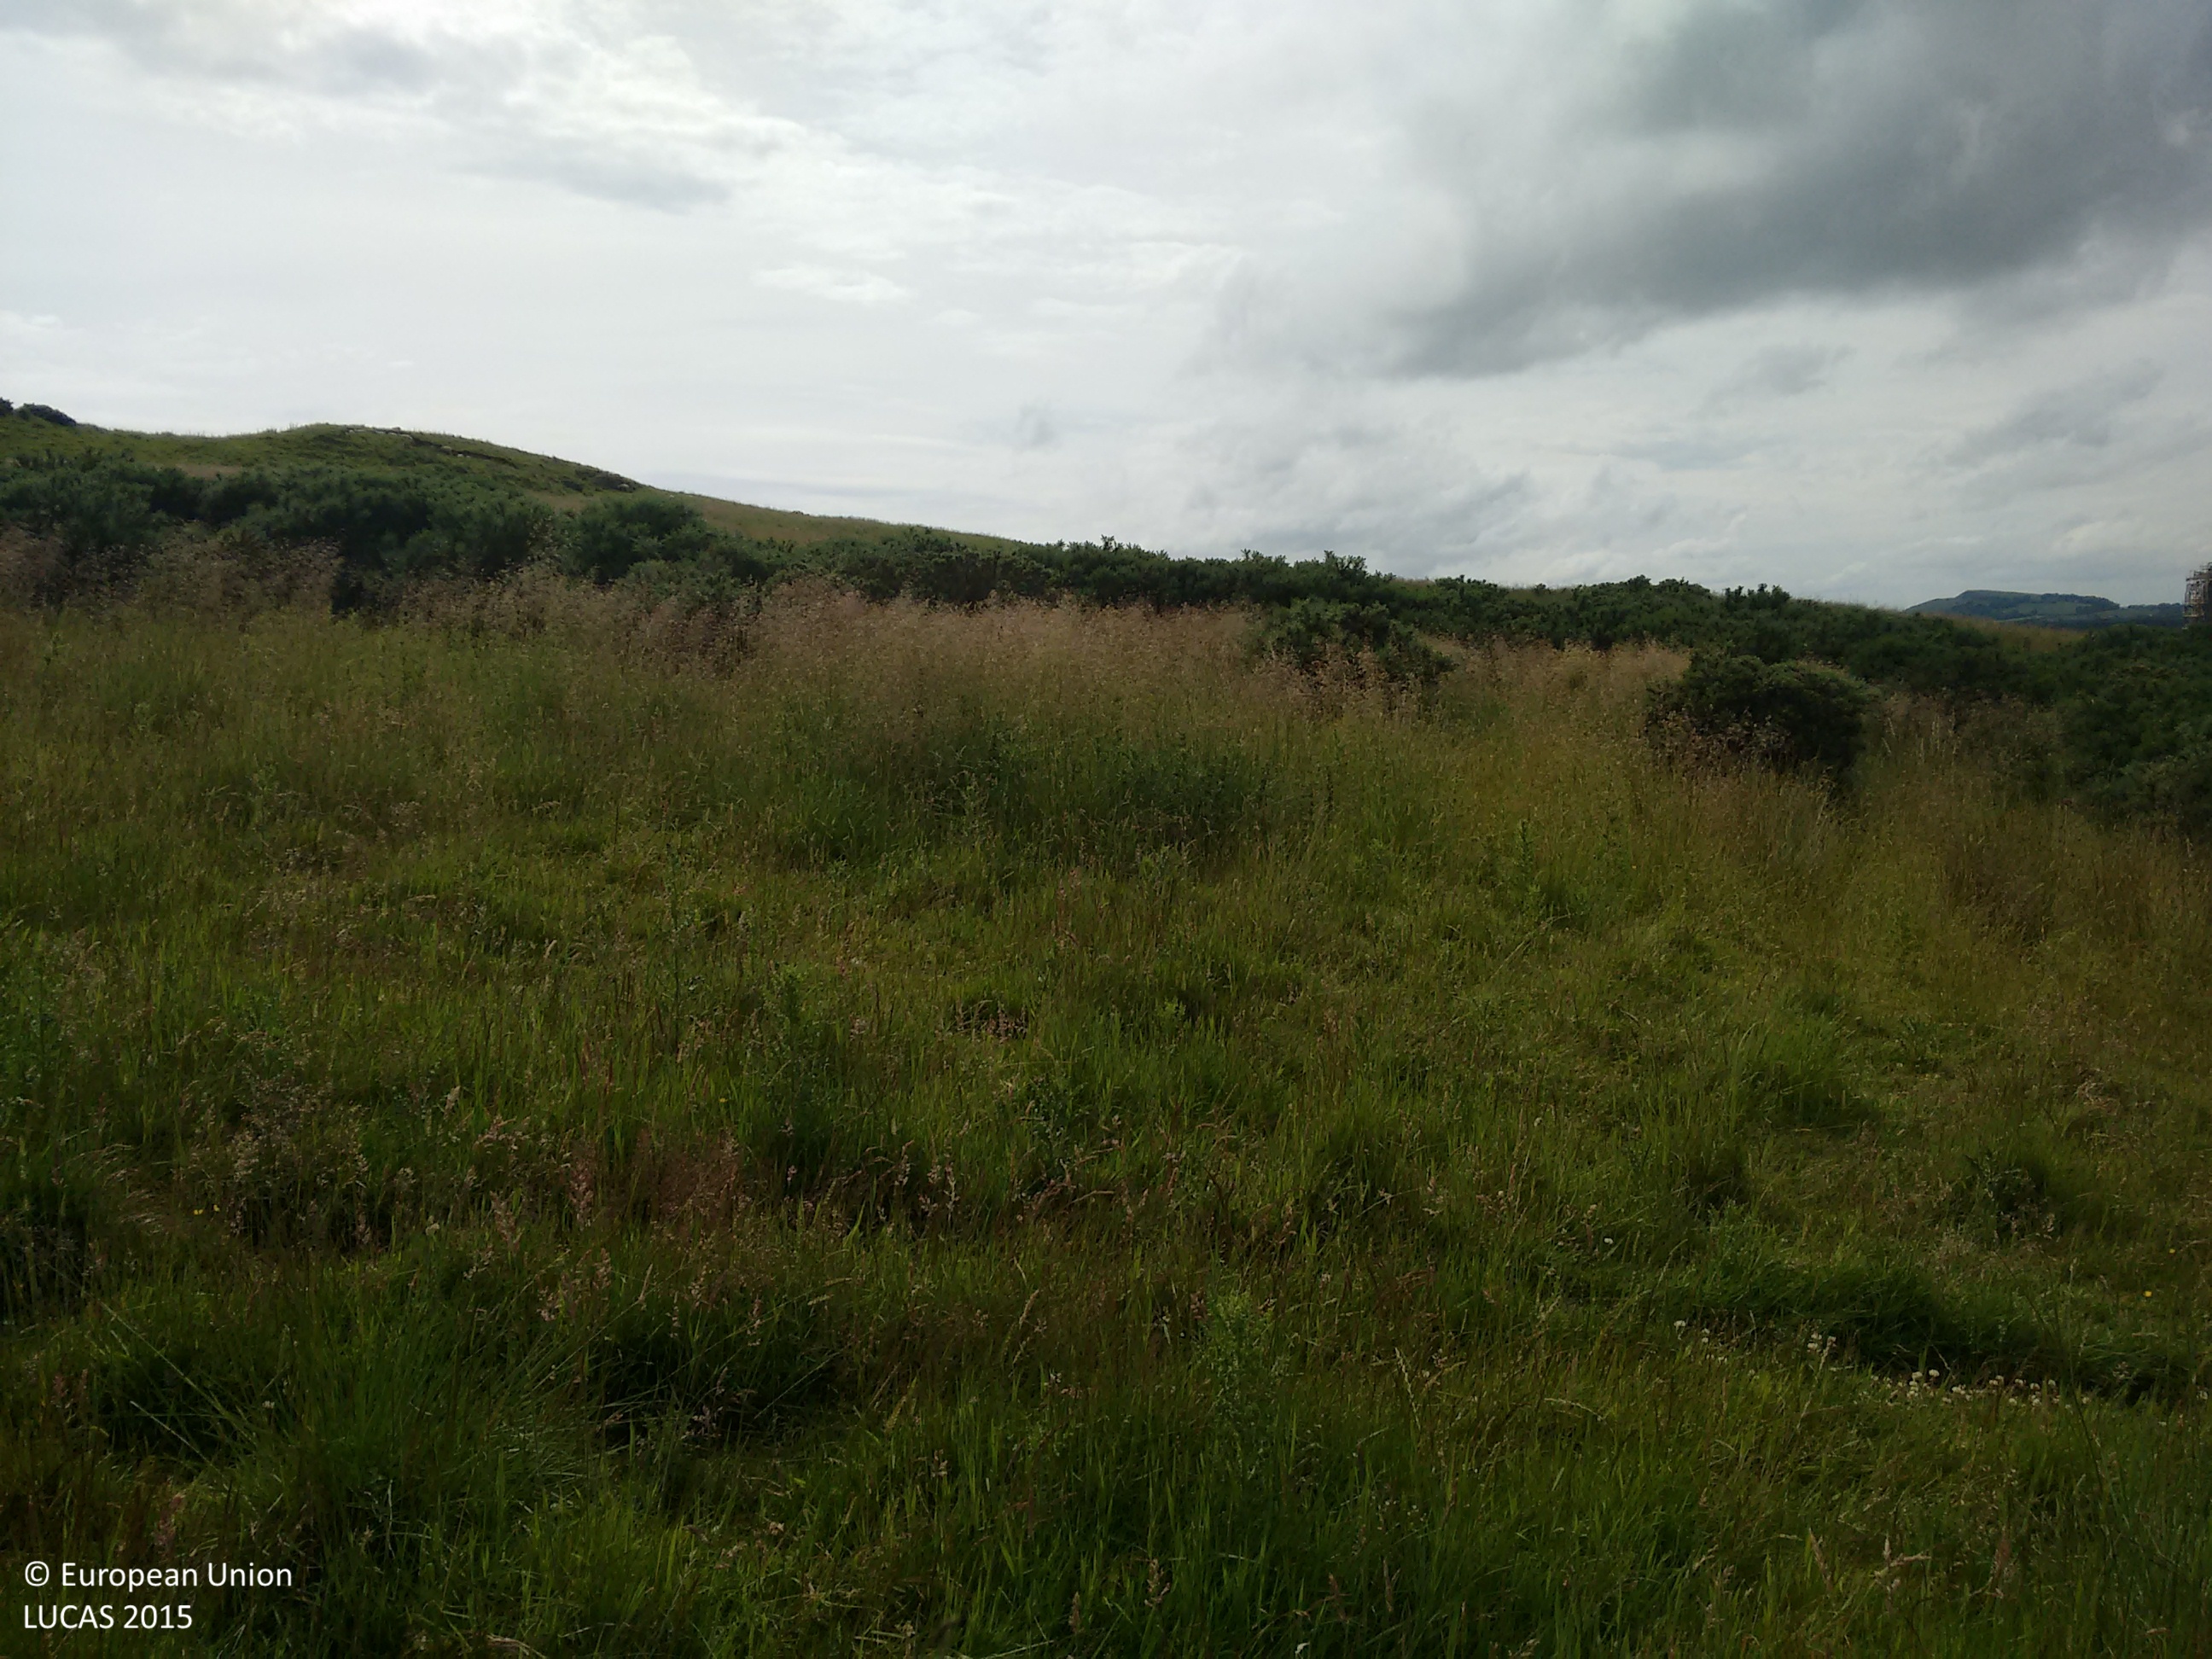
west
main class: Grassland
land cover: Grassland with sparse tree/shrub cover
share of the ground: > 75 %
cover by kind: herbaceous plants 90 %, broadleaved forest trees 5 %, shrubs 5 %
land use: Agriculture (excluding fallow land and kitchen gardens)
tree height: < 5 m
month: July
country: GB
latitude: 56.0935
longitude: -3.3016
